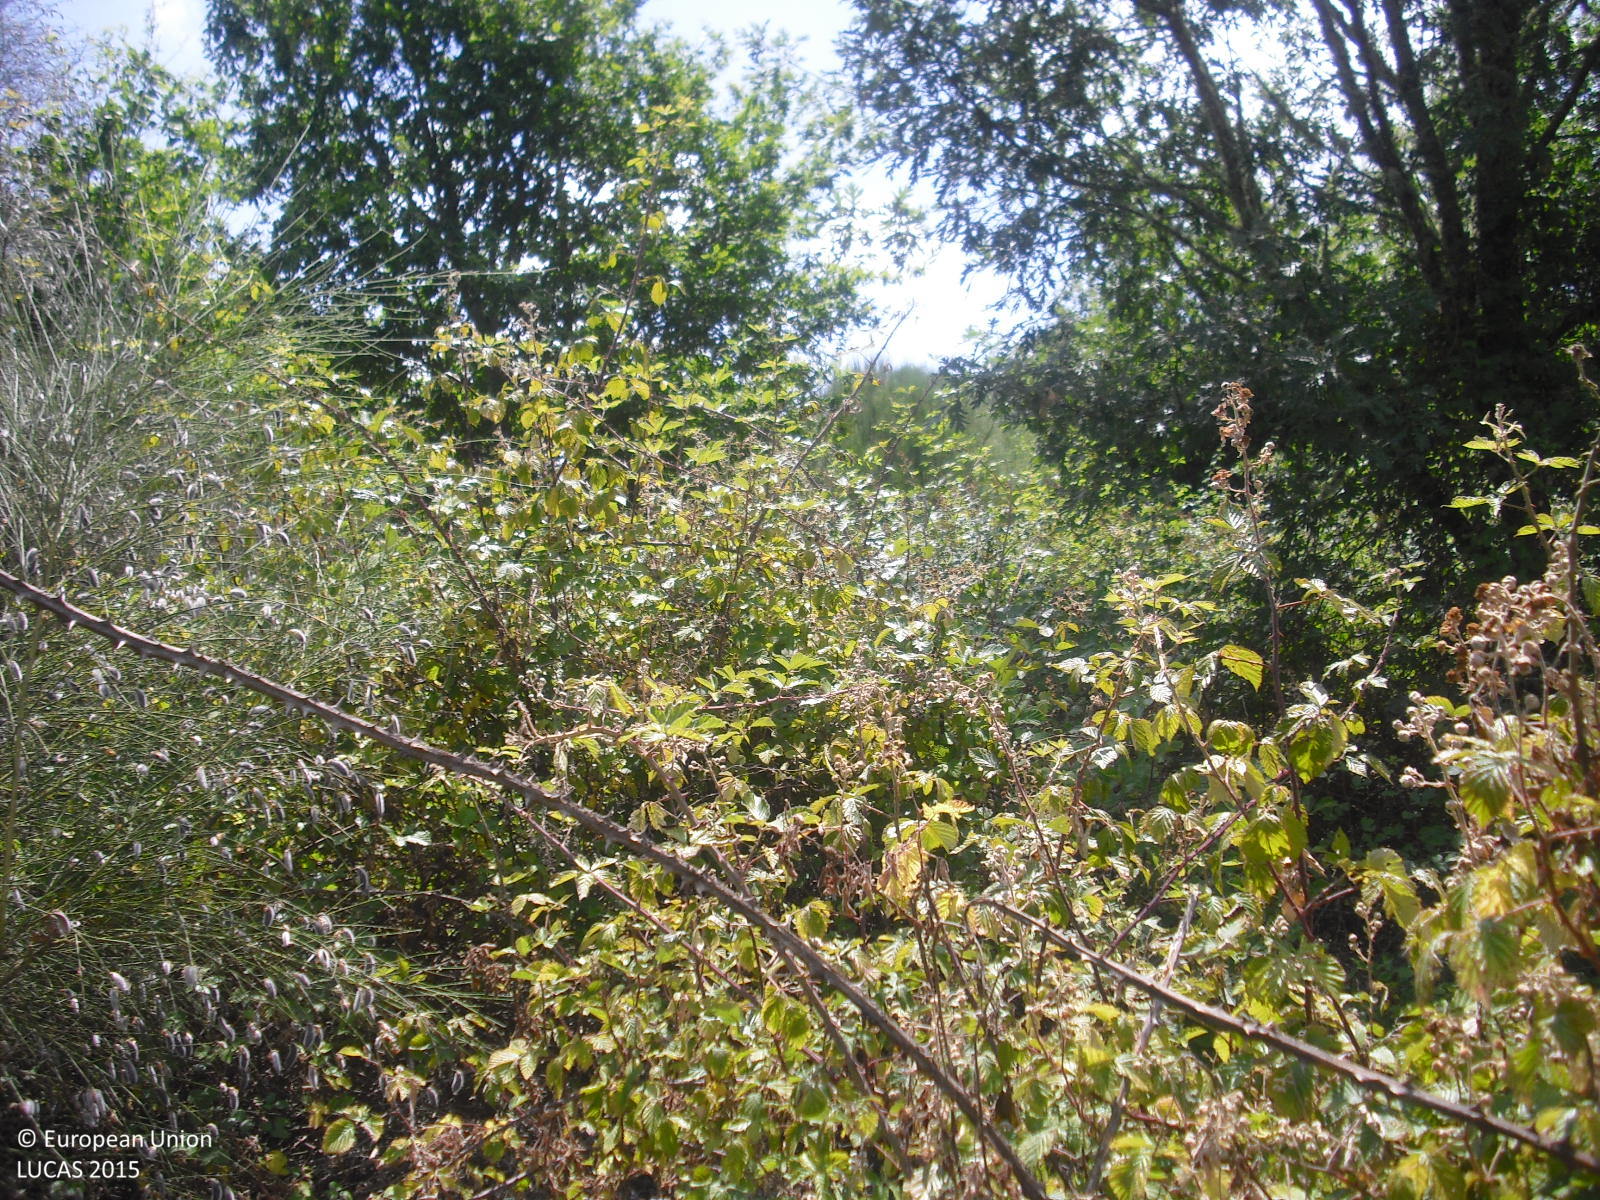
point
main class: Woodland
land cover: Broadleaved woodland
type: thermophilous deciduous forest
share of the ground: 25 - 50 %
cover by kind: shrubs 60 %, broadleaved forest trees 30 %, herbaceous plants 10 %
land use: Semi-natural and natural areas not in use
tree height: > 5 m
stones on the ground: < 10 %
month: July
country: ES
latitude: 42.3509
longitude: -7.7120
